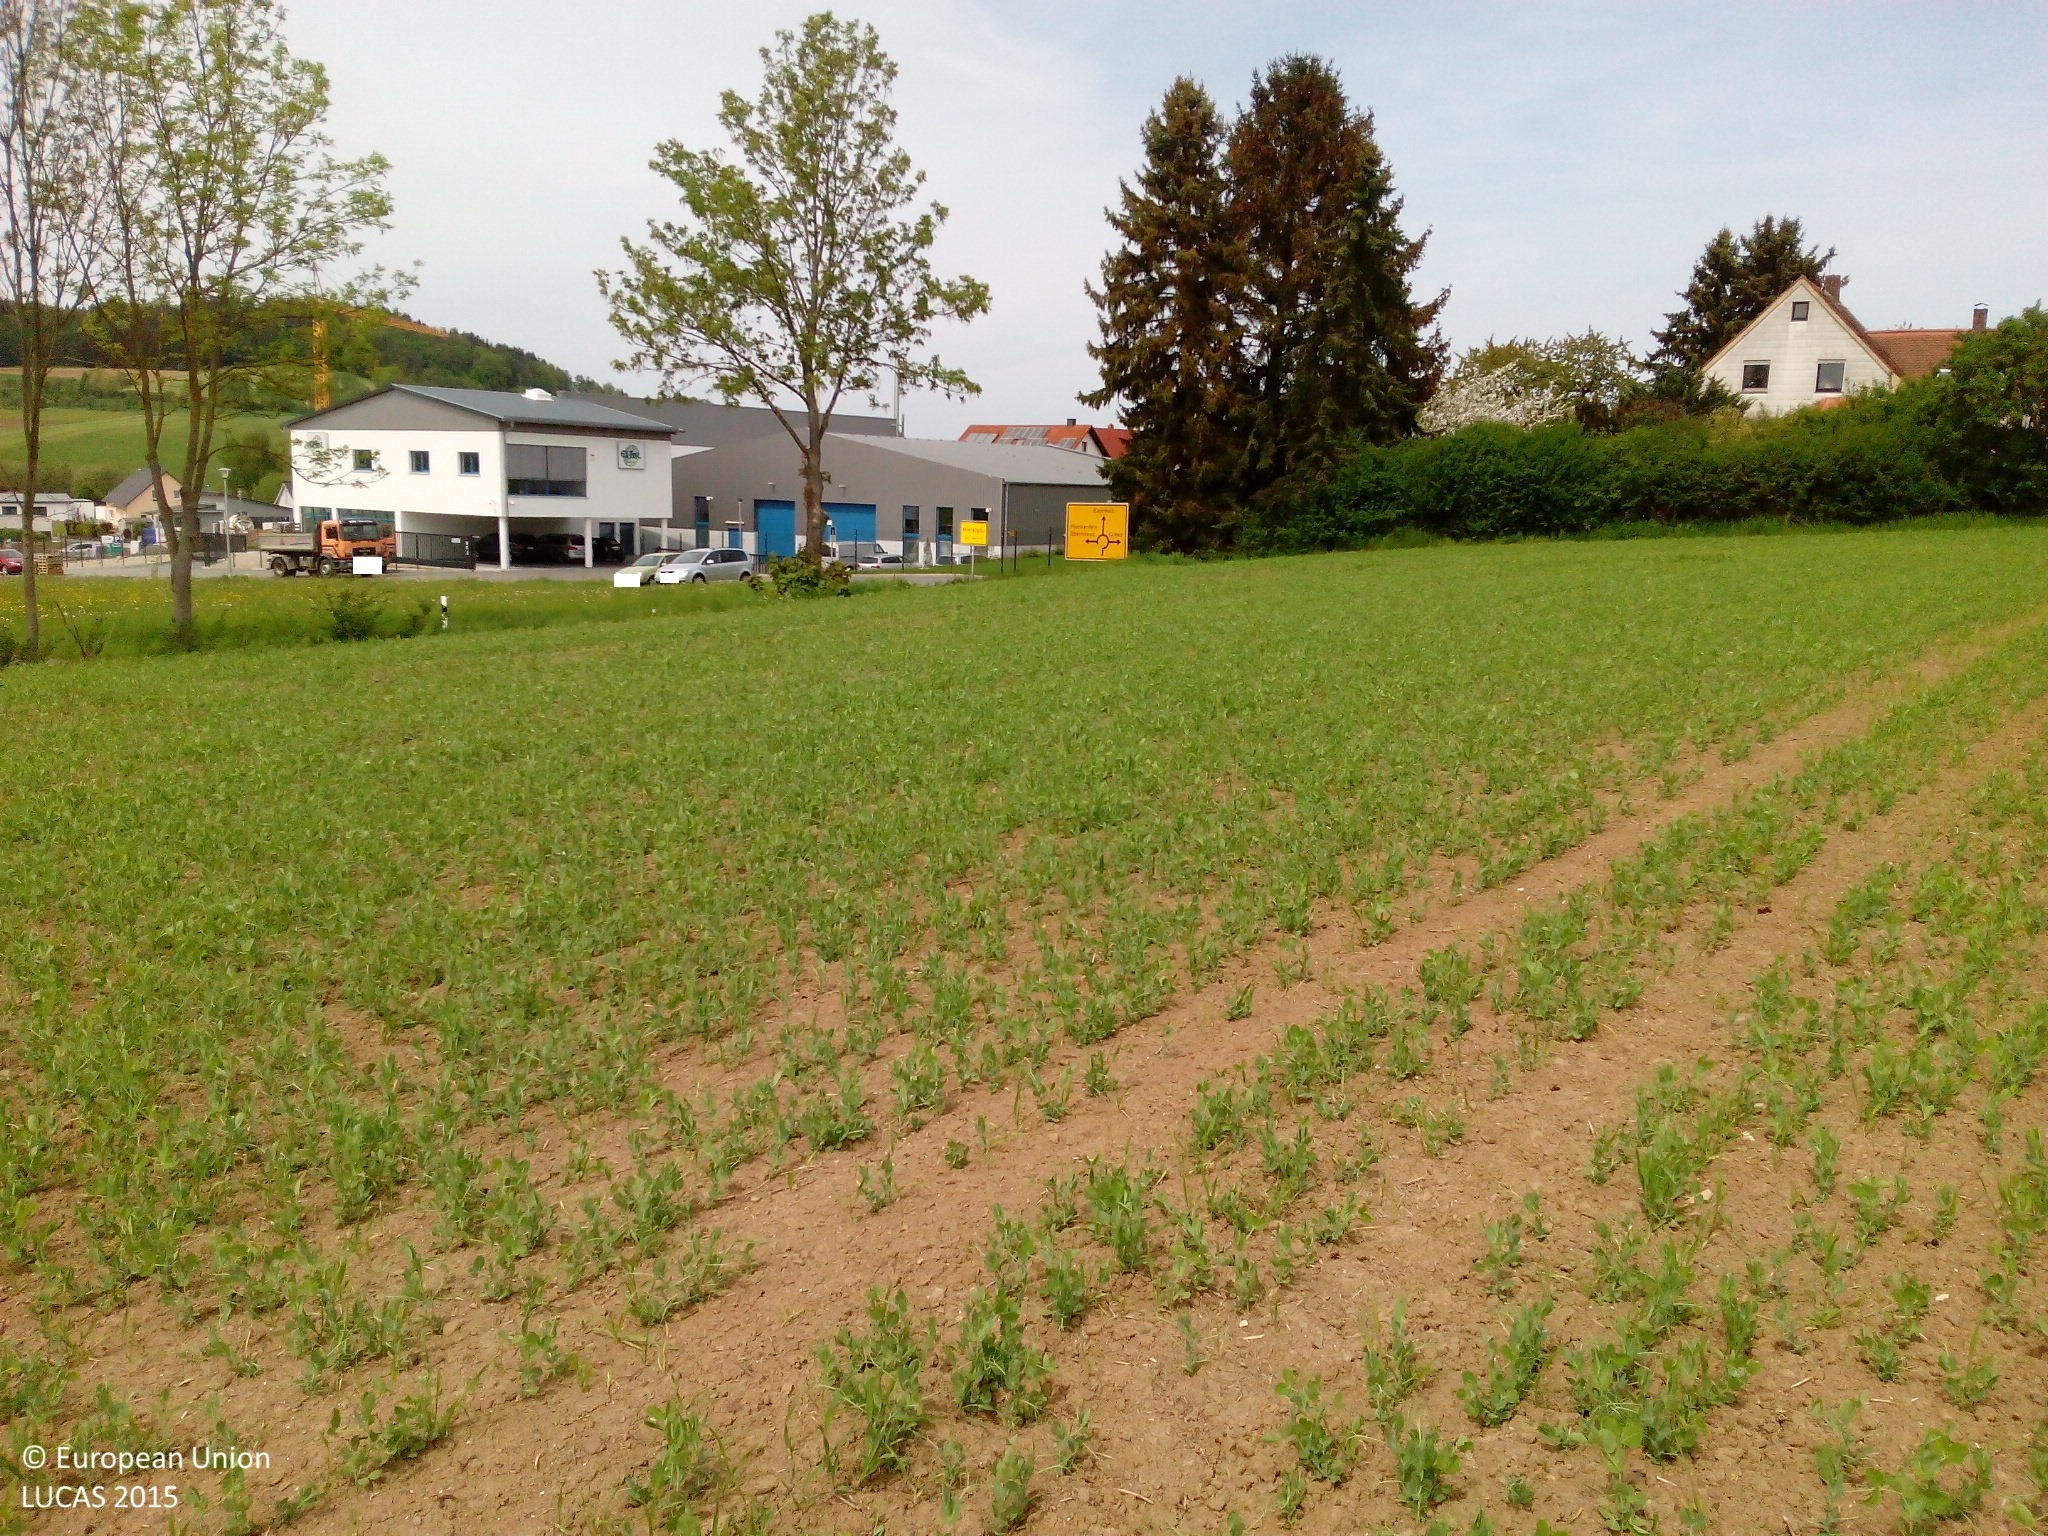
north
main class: Cropland
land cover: Dry pulses
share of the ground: 25 - 50 %
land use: Agriculture (excluding fallow land and kitchen gardens)
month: May
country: DE
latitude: 49.9051
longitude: 11.4616
